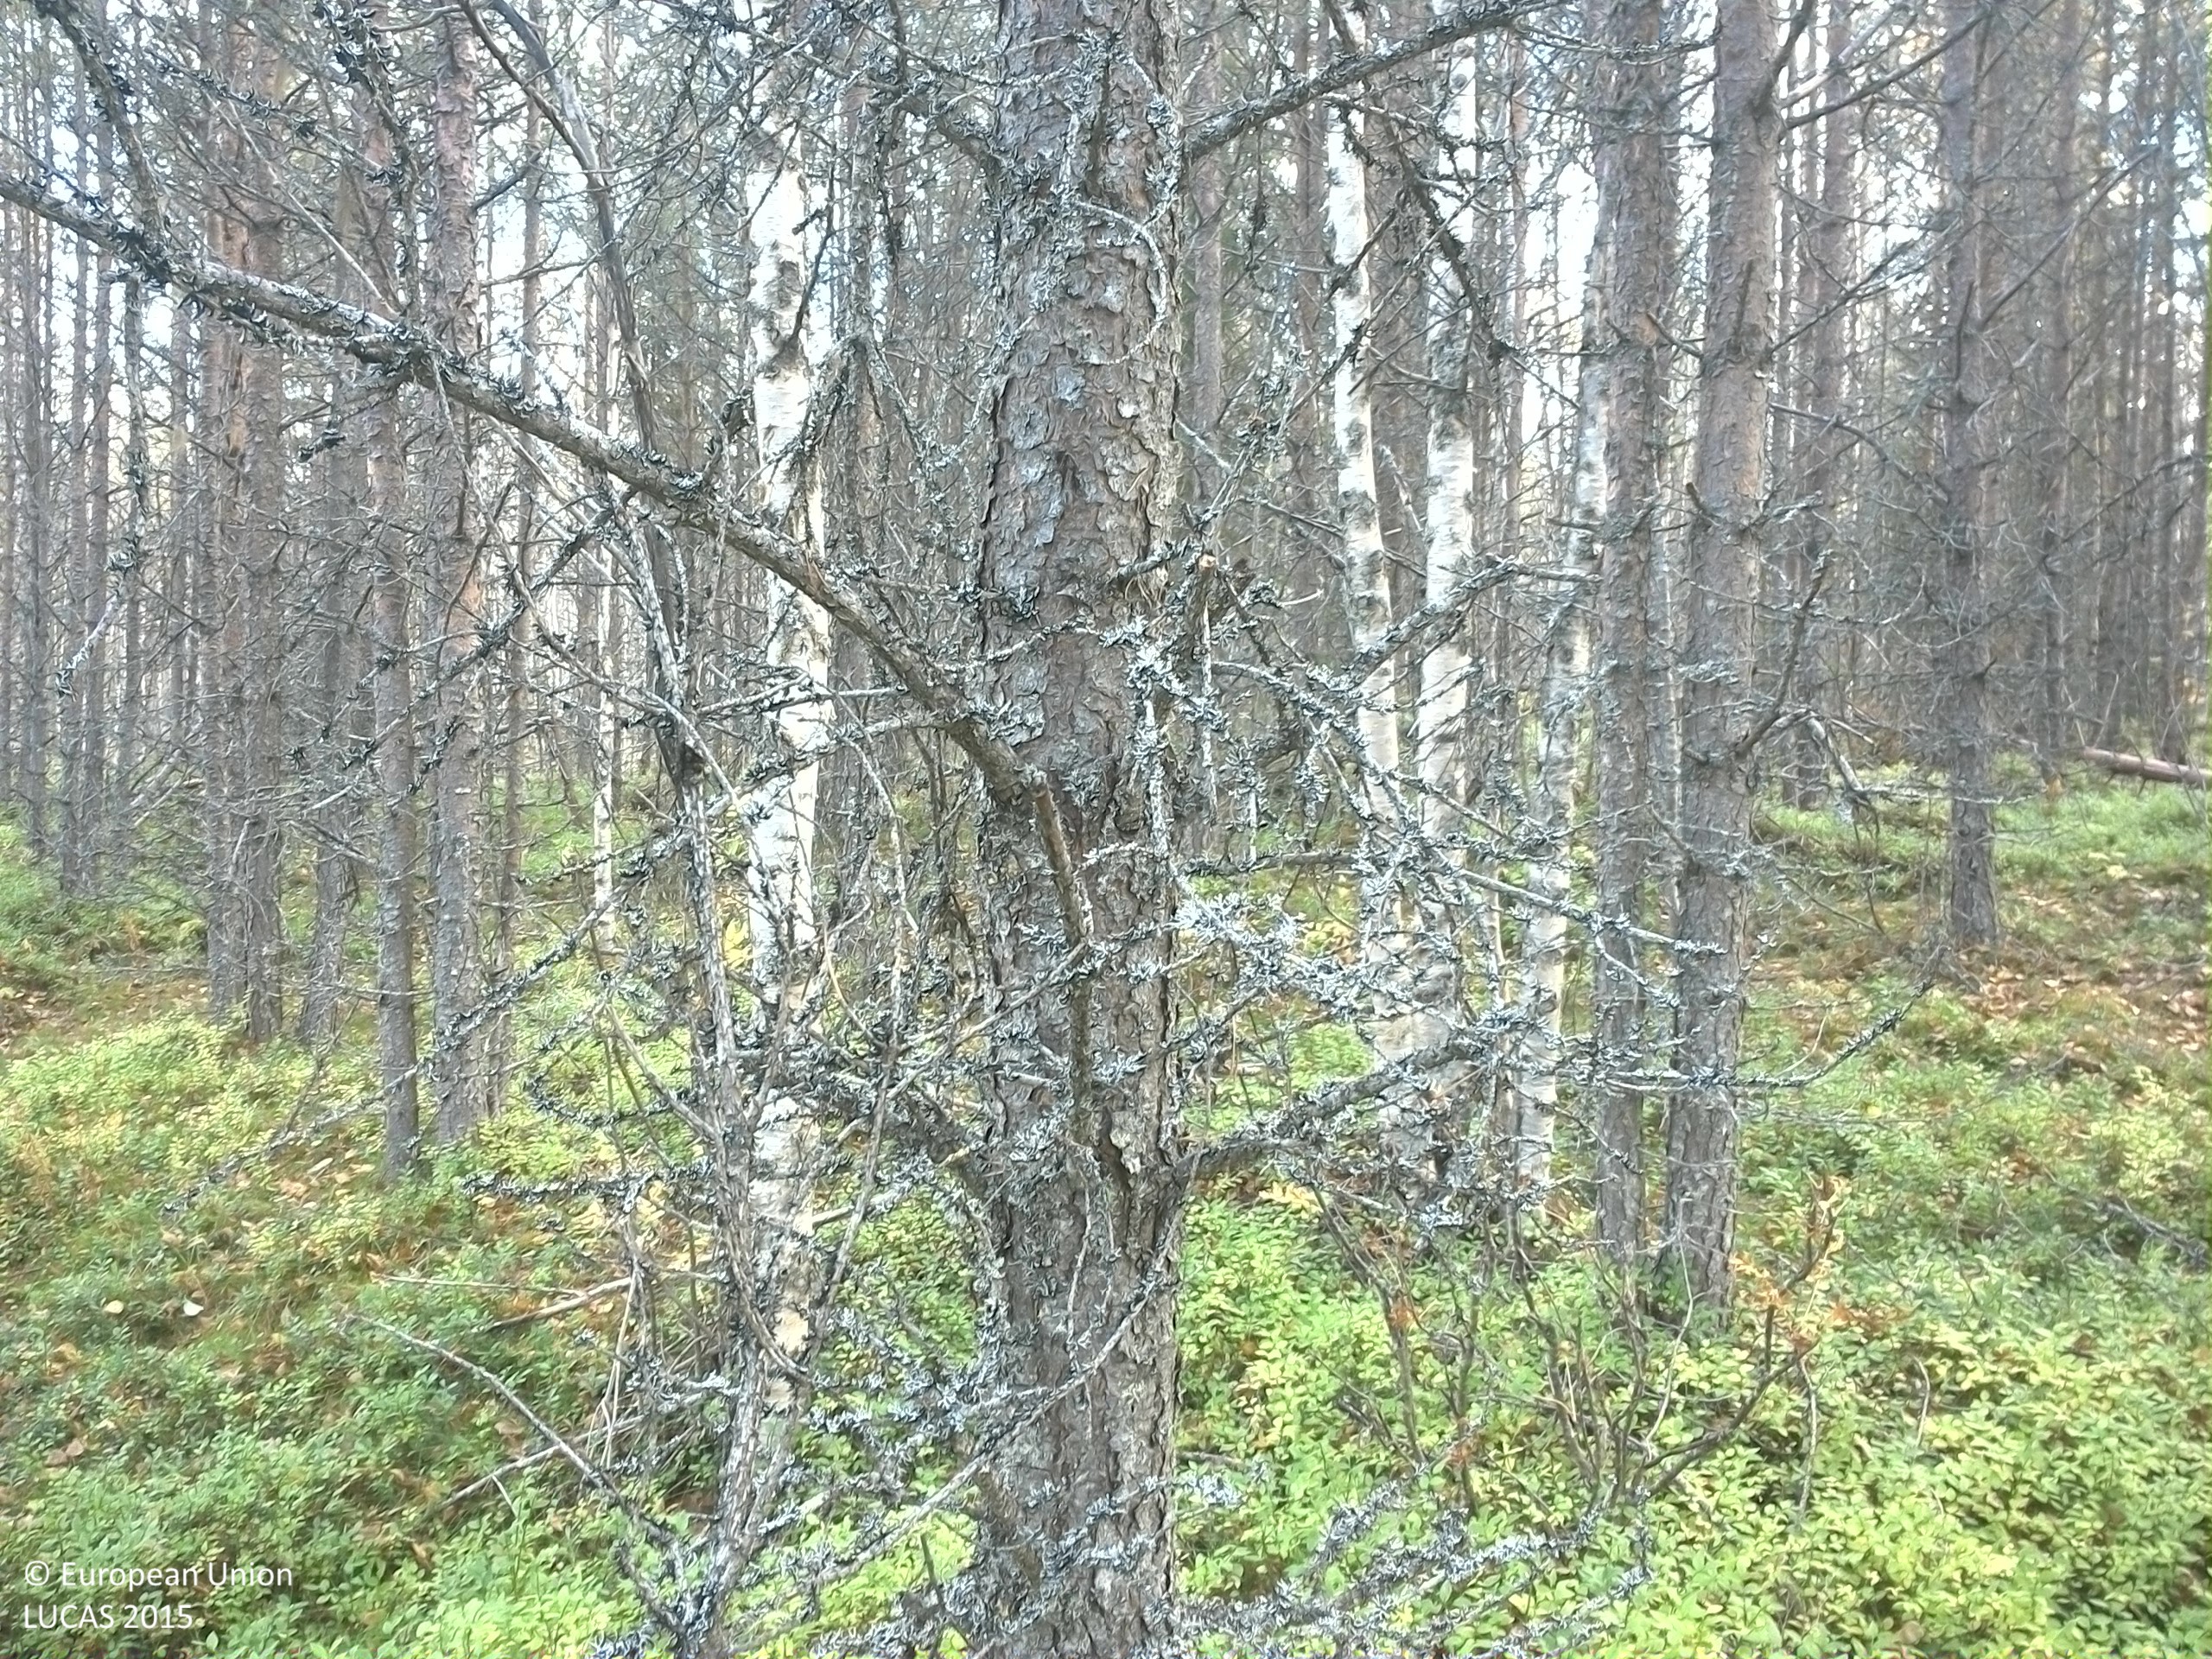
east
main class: Woodland
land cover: Pine dominated mixed woodland
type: boreal forest
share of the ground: 50 - 75 %
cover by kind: coniferous forest trees 40 %, shrubs 25 %, broadleaved forest trees 20 %, lichens and mosses 10 %, herbaceous plants 5 %
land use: Forestry
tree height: > 5 m
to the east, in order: Pine dominated mixed woodland; Spruce dominated mixed woodland; Inland fresh running water; Spruce dominated coniferous woodland
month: October
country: SE
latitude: 64.2705
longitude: 15.8956
